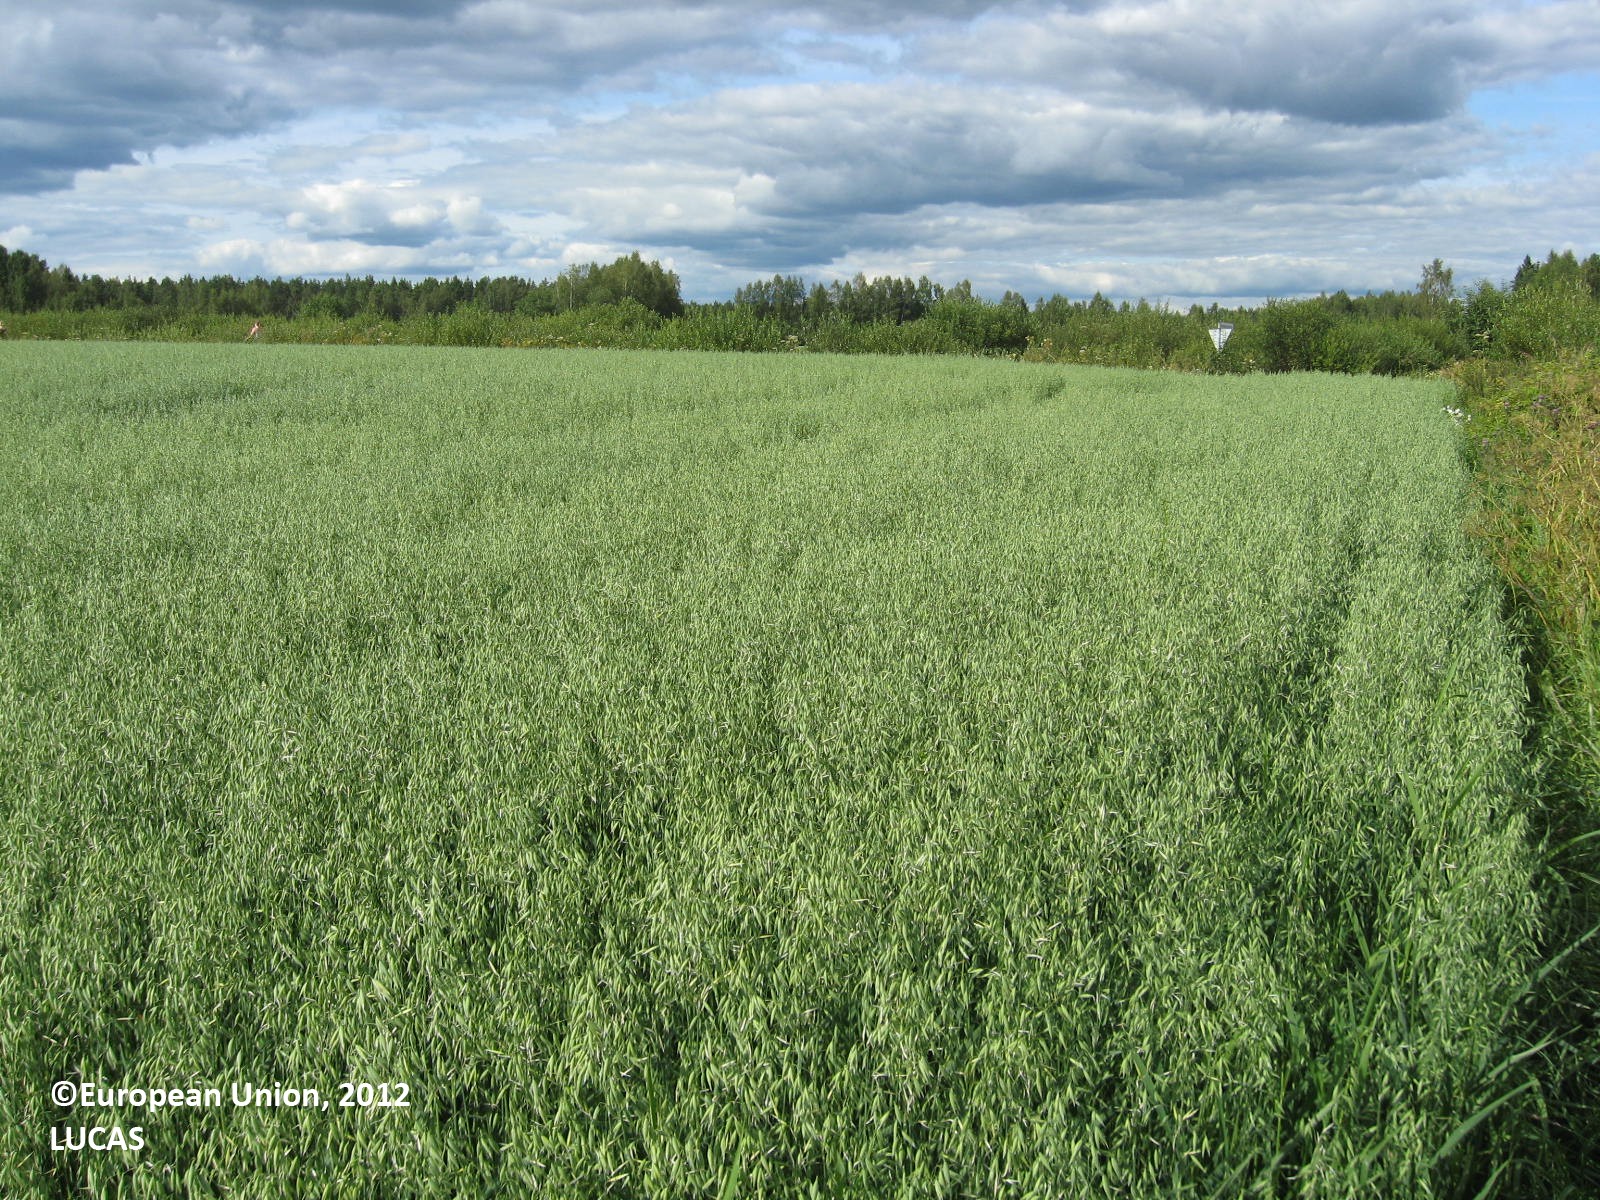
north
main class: Cropland
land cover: Oats
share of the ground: > 75 %
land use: Agriculture (excluding fallow land and kitchen gardens)
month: July
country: FI
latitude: 61.9997
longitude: 22.2572
